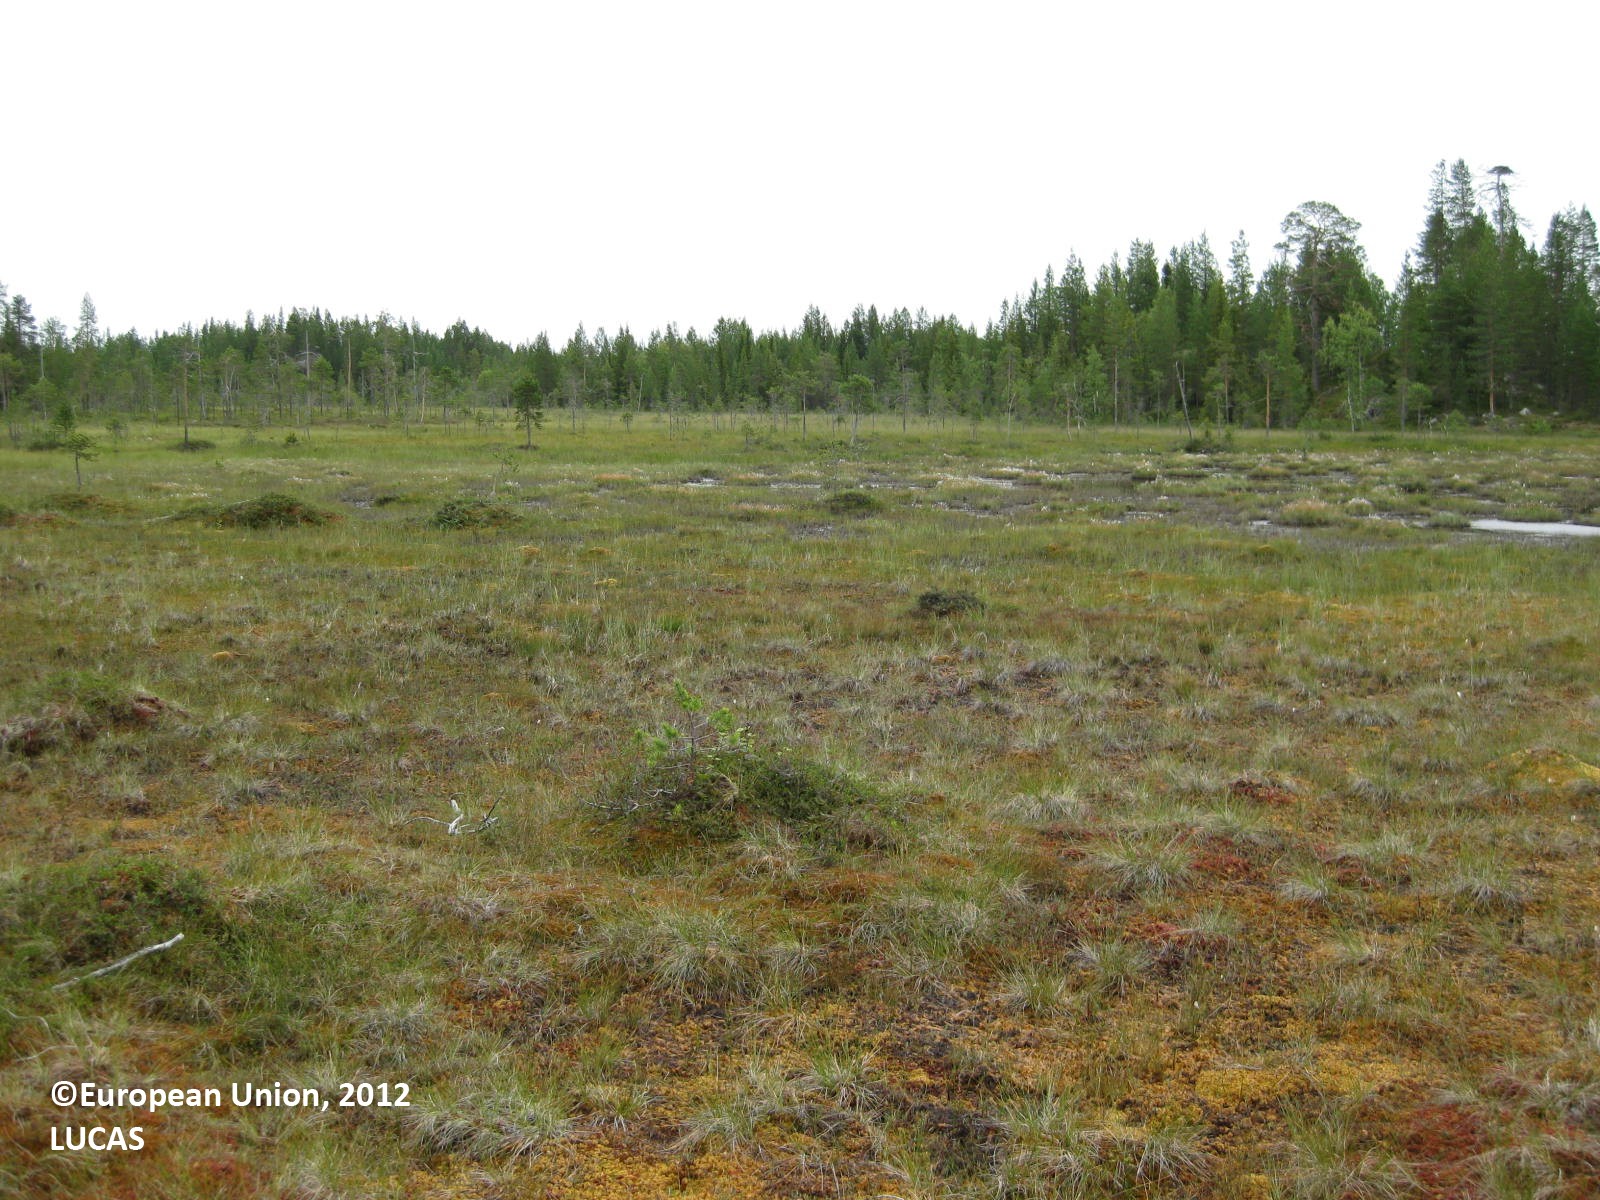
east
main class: Woodland
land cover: Pine dominated coniferous woodland
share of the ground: 25 - 50 %
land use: Semi-natural and natural areas not in use
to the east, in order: Peatbogs; Inland marshes; Pine dominated coniferous woodland; Ponds and wetlands; Pine dominated coniferous woodland; Ponds and wetlands; Pine dominated coniferous woodland; Ponds and wetlands; Pine dominated coniferous woodland; Other coniferous woodland
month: August
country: FI
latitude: 66.3020
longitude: 28.3612
